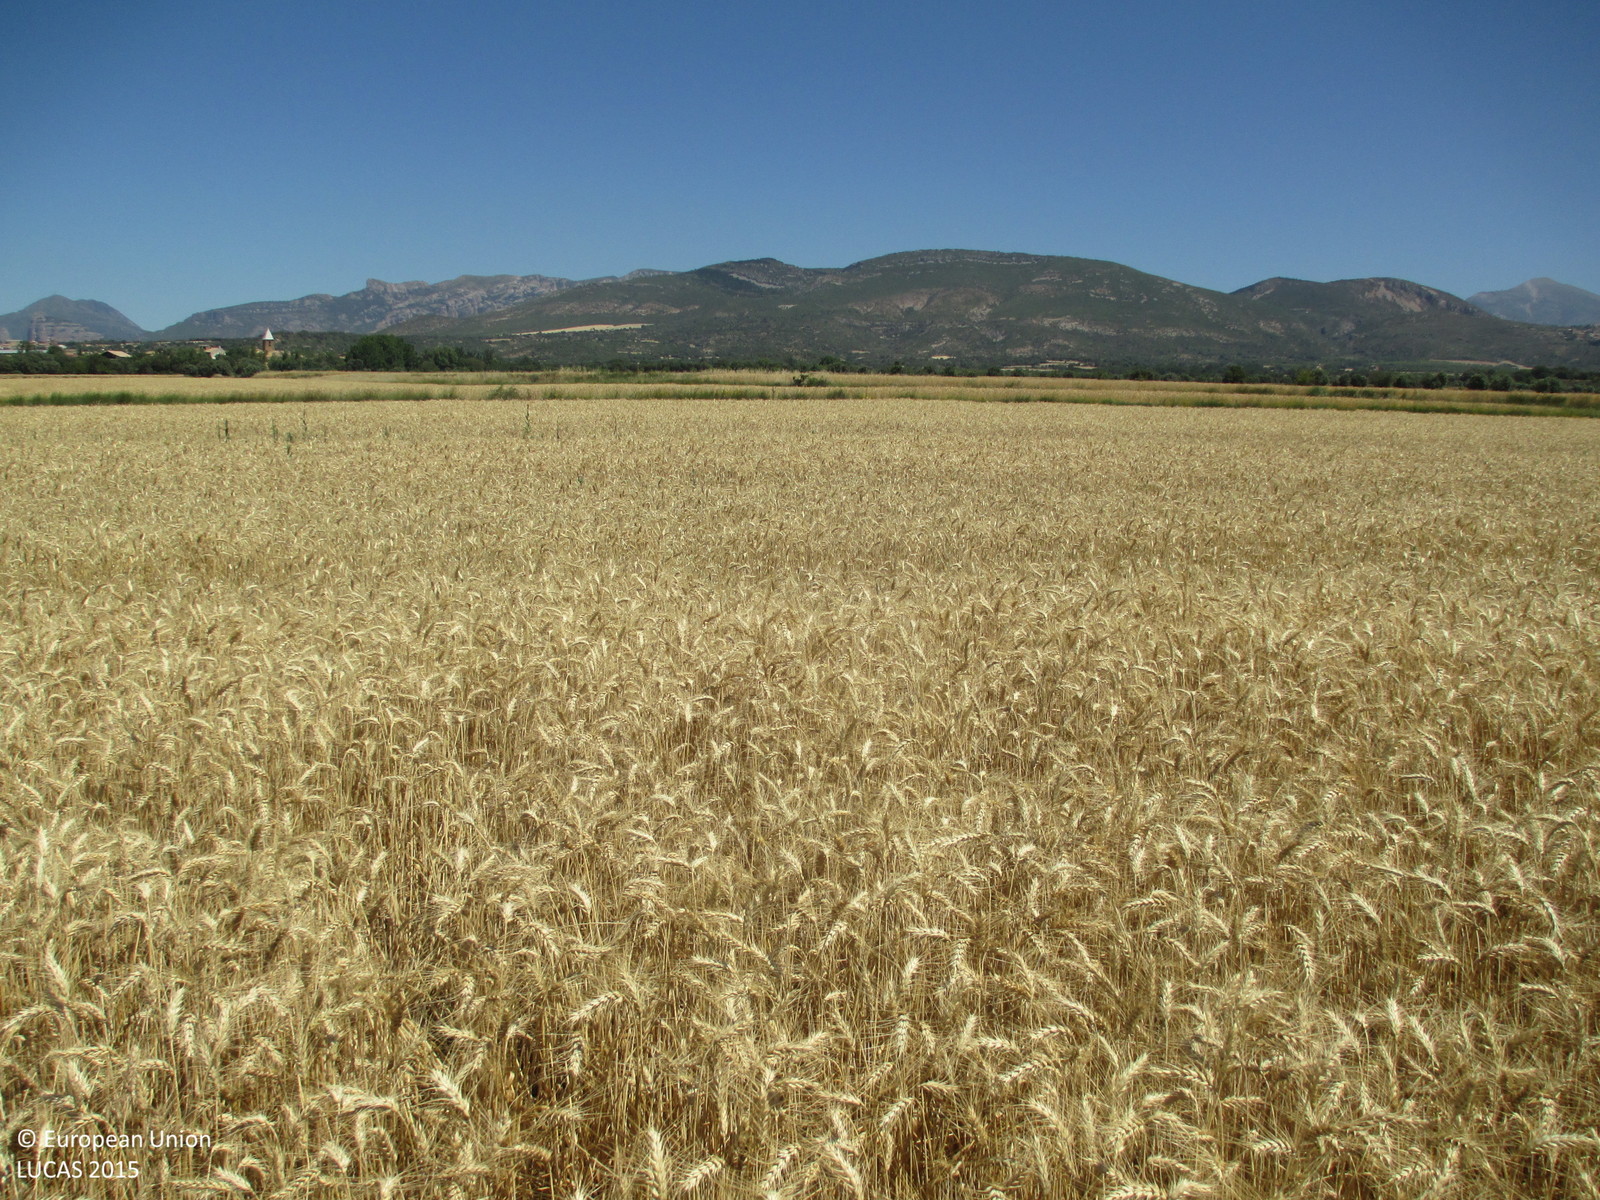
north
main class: Cropland
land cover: Durum wheat
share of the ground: > 75 %
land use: Agriculture (excluding fallow land and kitchen gardens)
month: June
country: ES
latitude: 42.1795
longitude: -0.3253
